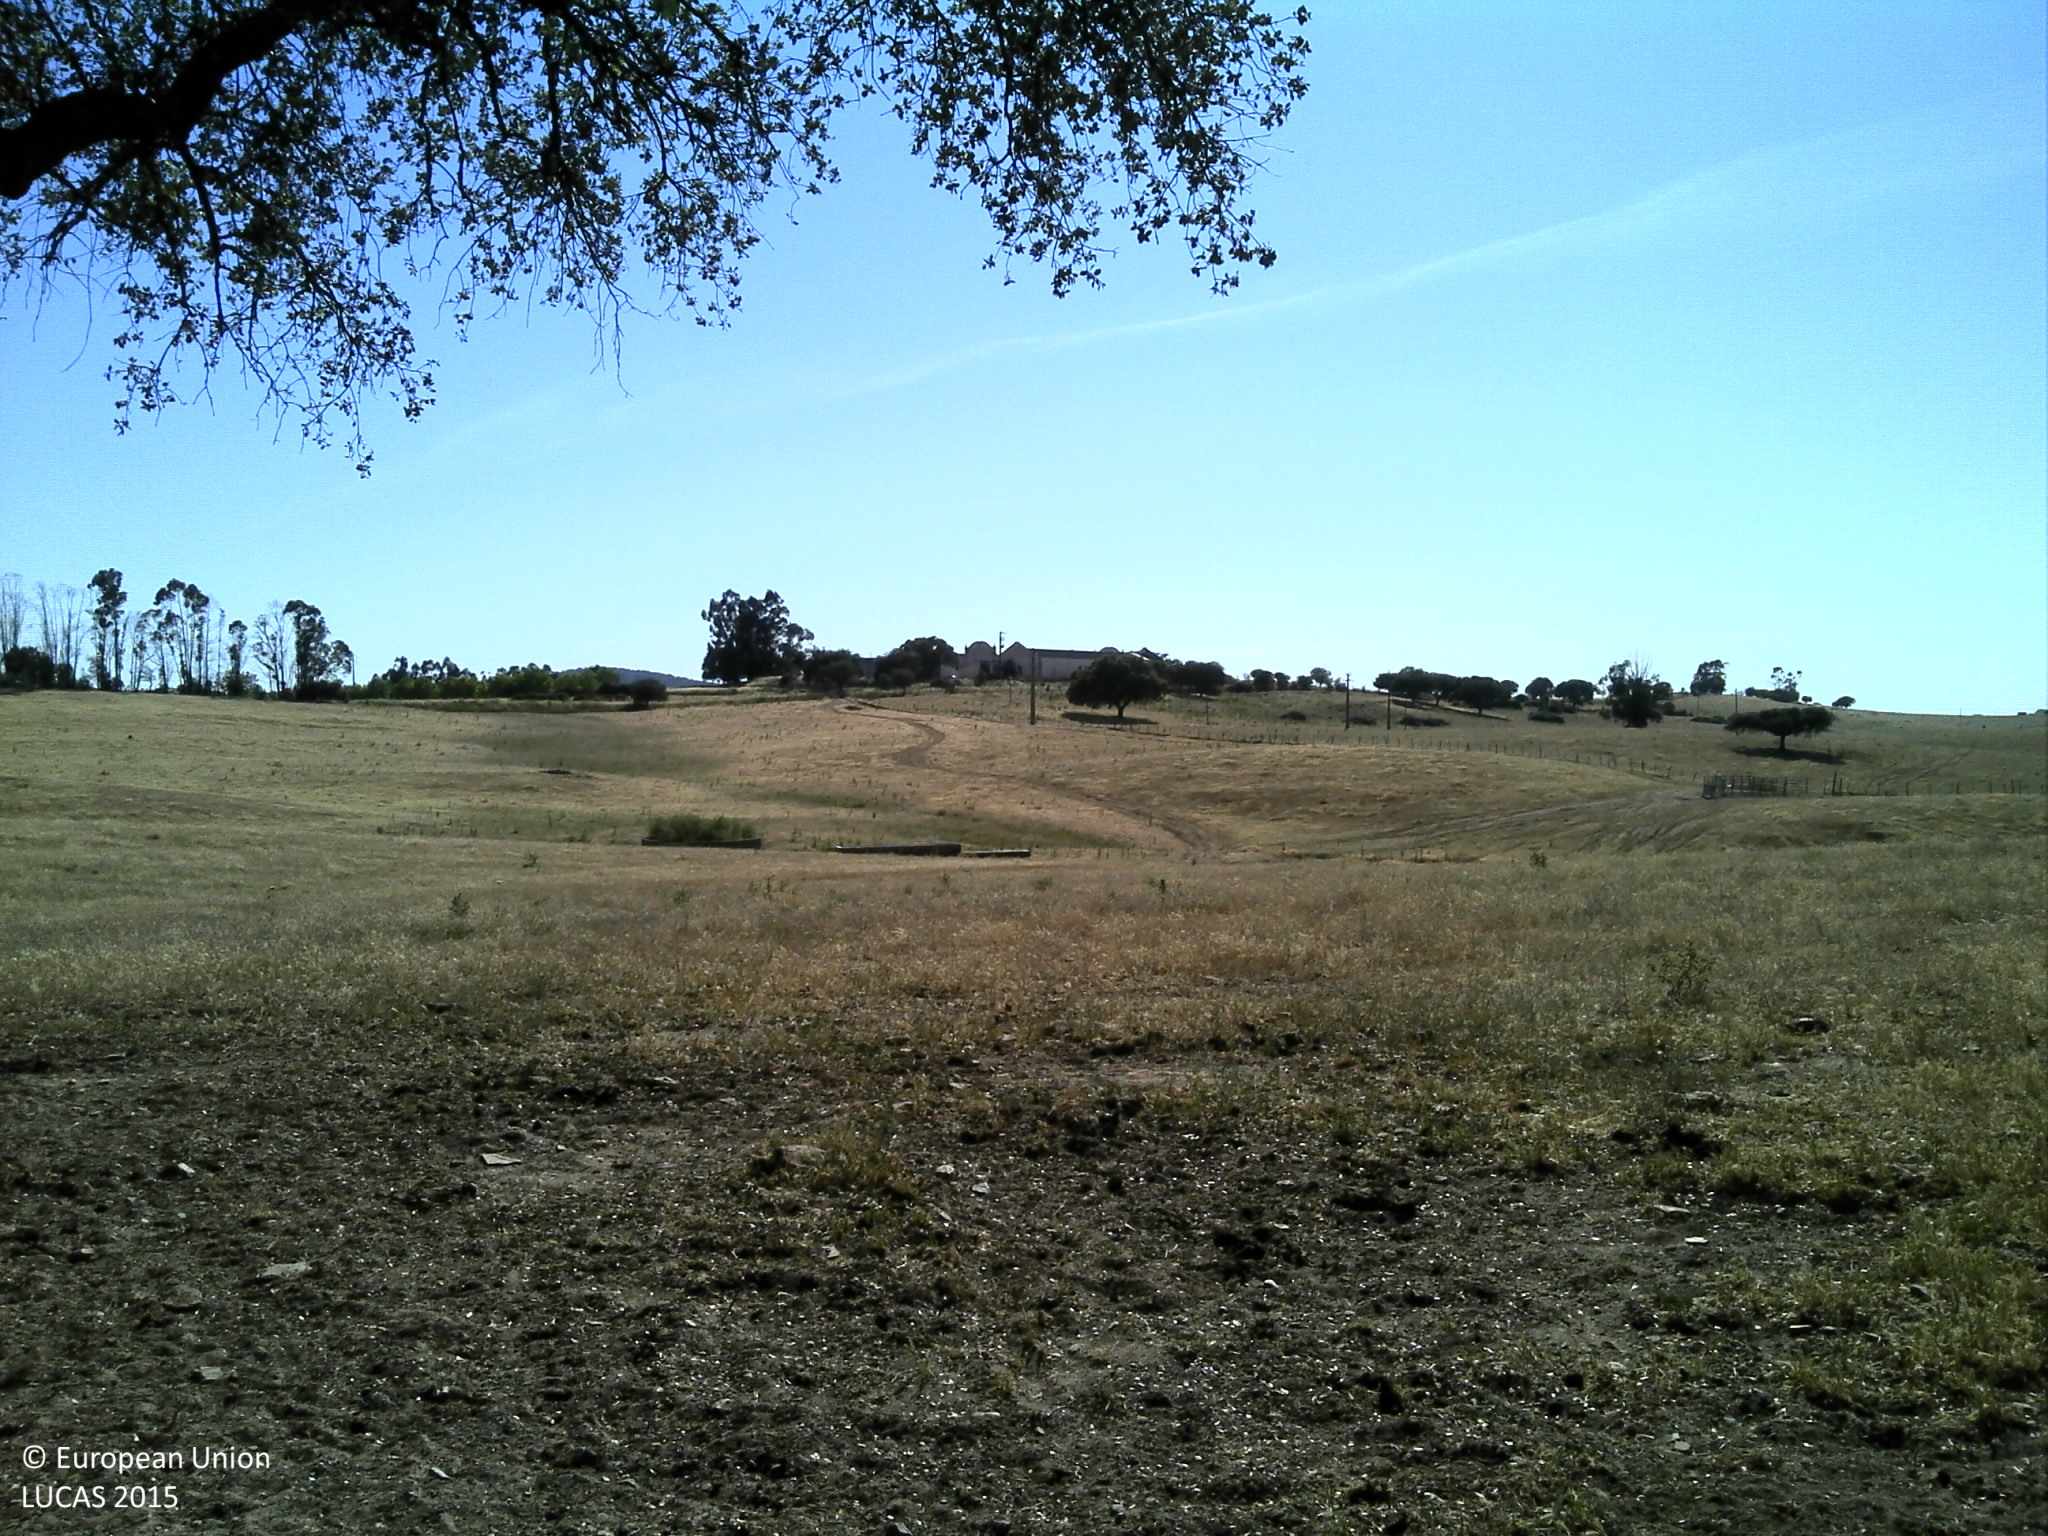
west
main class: Grassland
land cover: Grassland with sparse tree/shrub cover
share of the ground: 50 - 75 %
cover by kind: herbaceous plants 75 %, unconsolidated bare surface 20 %, broadleaved forest trees 5 %
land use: Agriculture (excluding fallow land and kitchen gardens)
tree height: > 5 m
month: May
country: PT
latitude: 39.2529
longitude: -7.6007
